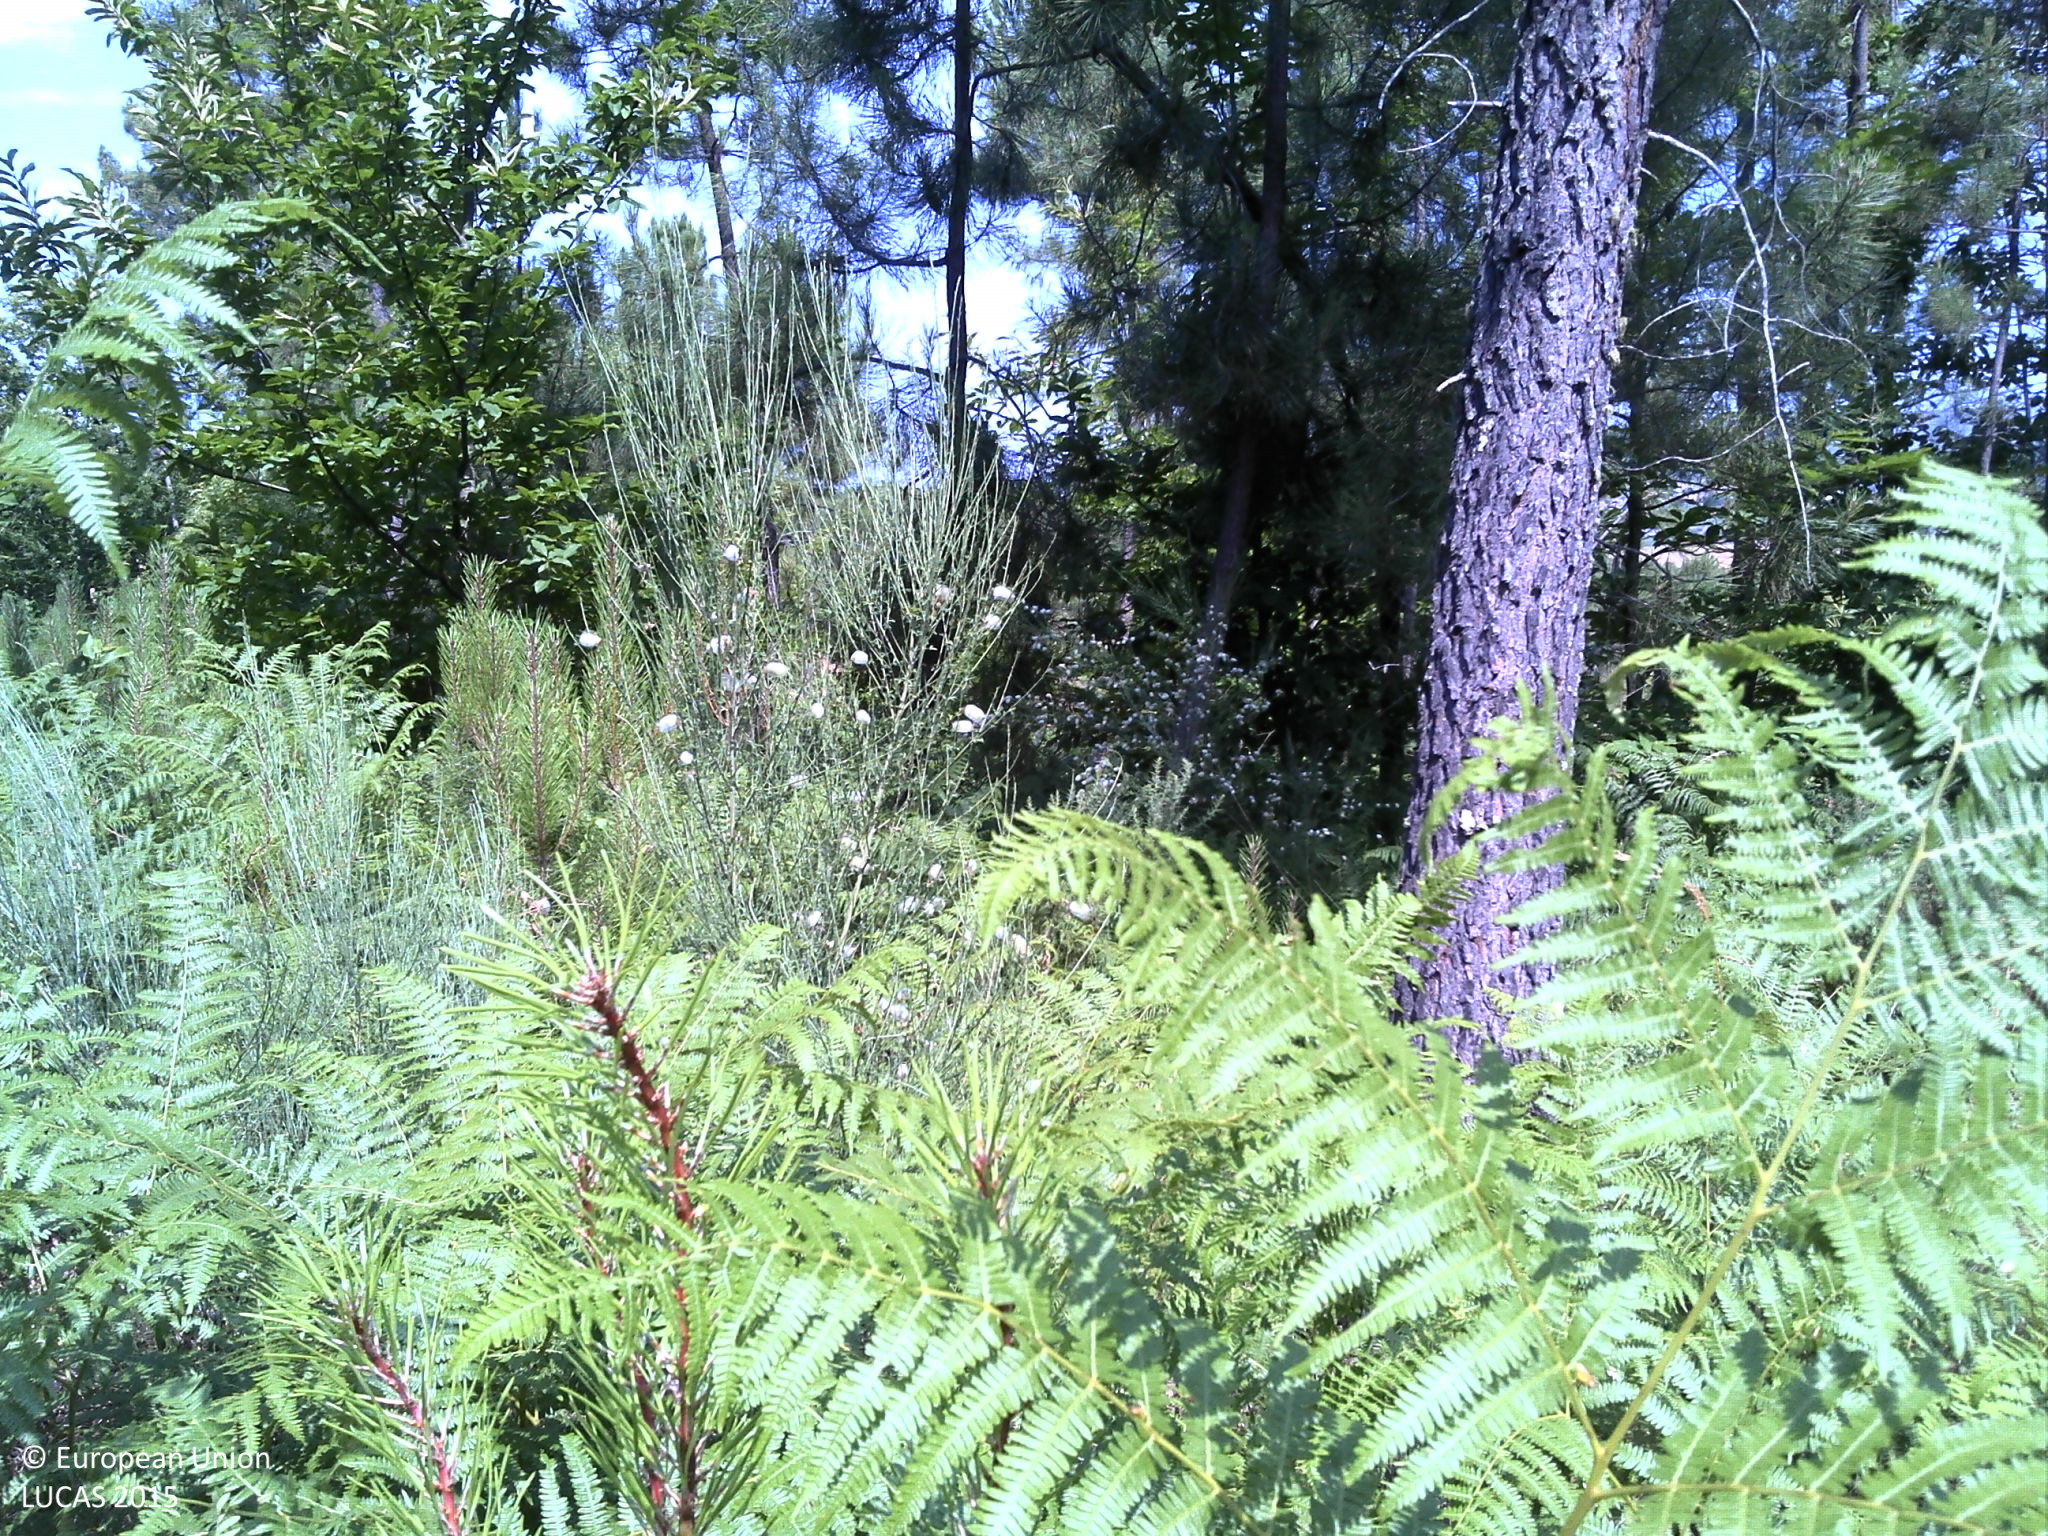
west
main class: Woodland
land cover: Pine dominated coniferous woodland
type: coniferous forest of the mediterranean region
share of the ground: 25 - 50 %
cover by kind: shrubs 70 %, coniferous forest trees 30 %
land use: Forestry
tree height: > 5 m
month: June
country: PT
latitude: 41.2489
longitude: -7.5842
